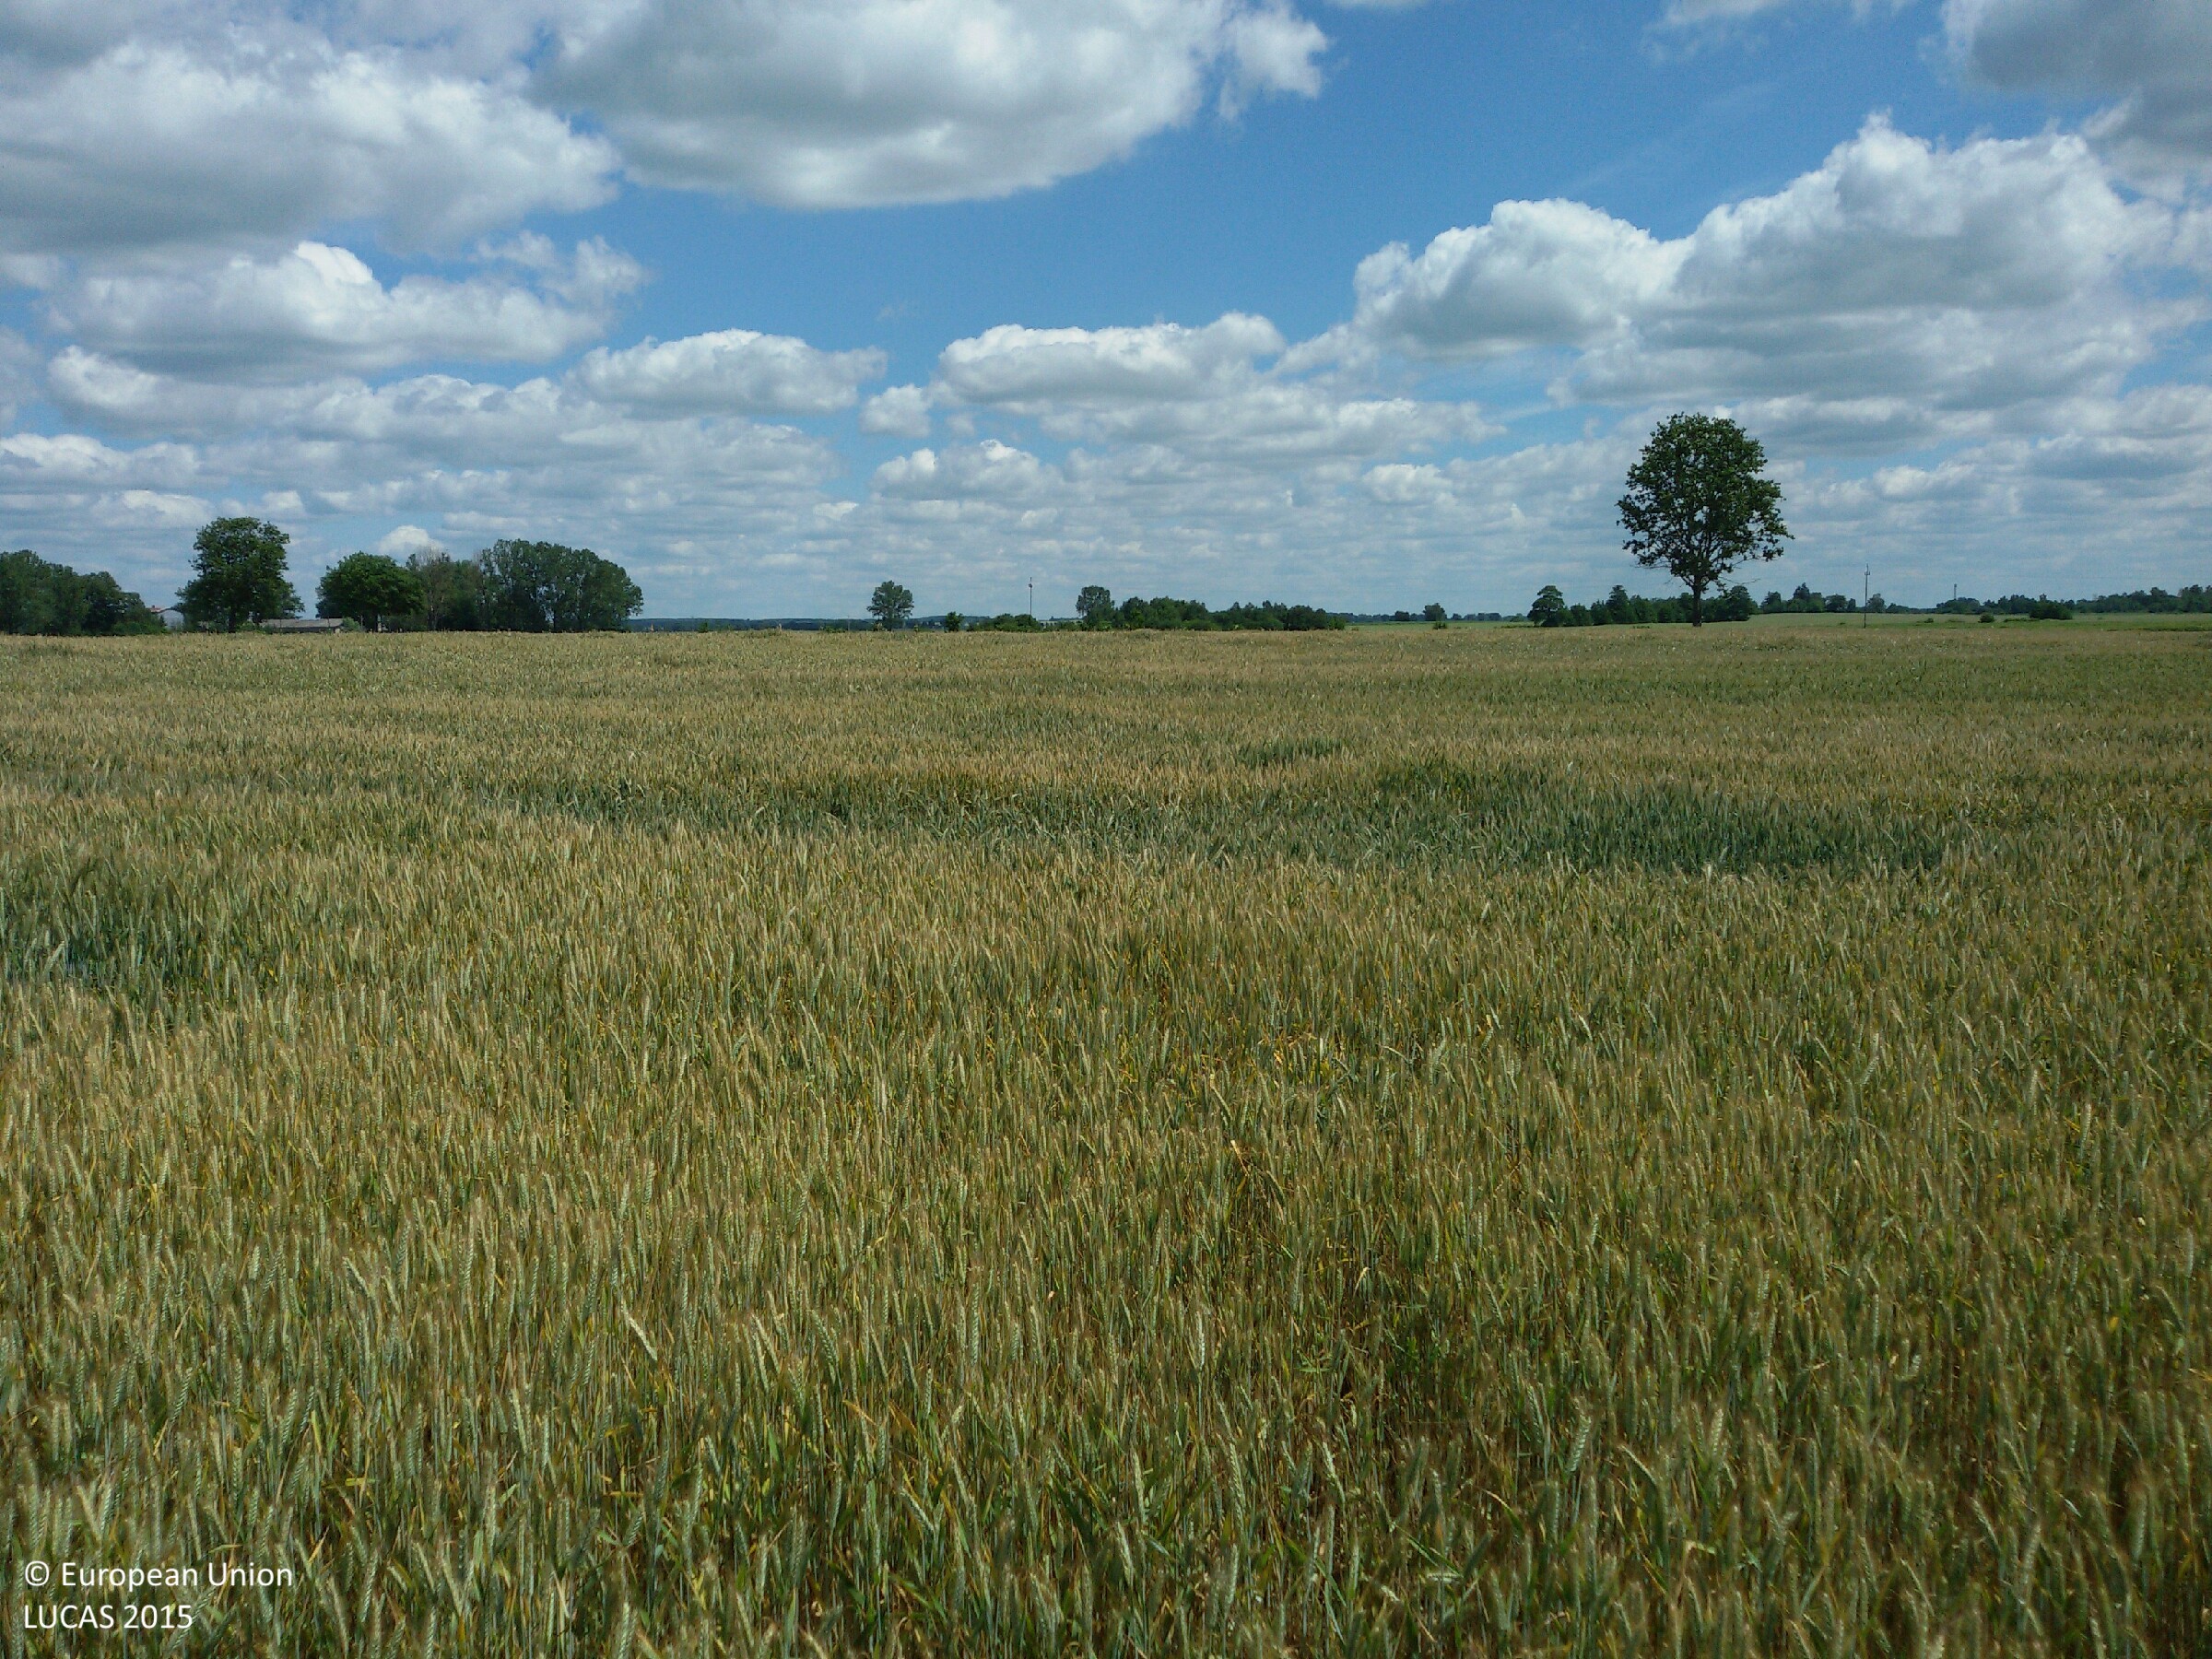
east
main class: Cropland
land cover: Common wheat
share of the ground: > 75 %
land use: Agriculture (excluding fallow land and kitchen gardens)
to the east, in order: Common wheat
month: July
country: PL
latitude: 53.3757
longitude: 20.1192
